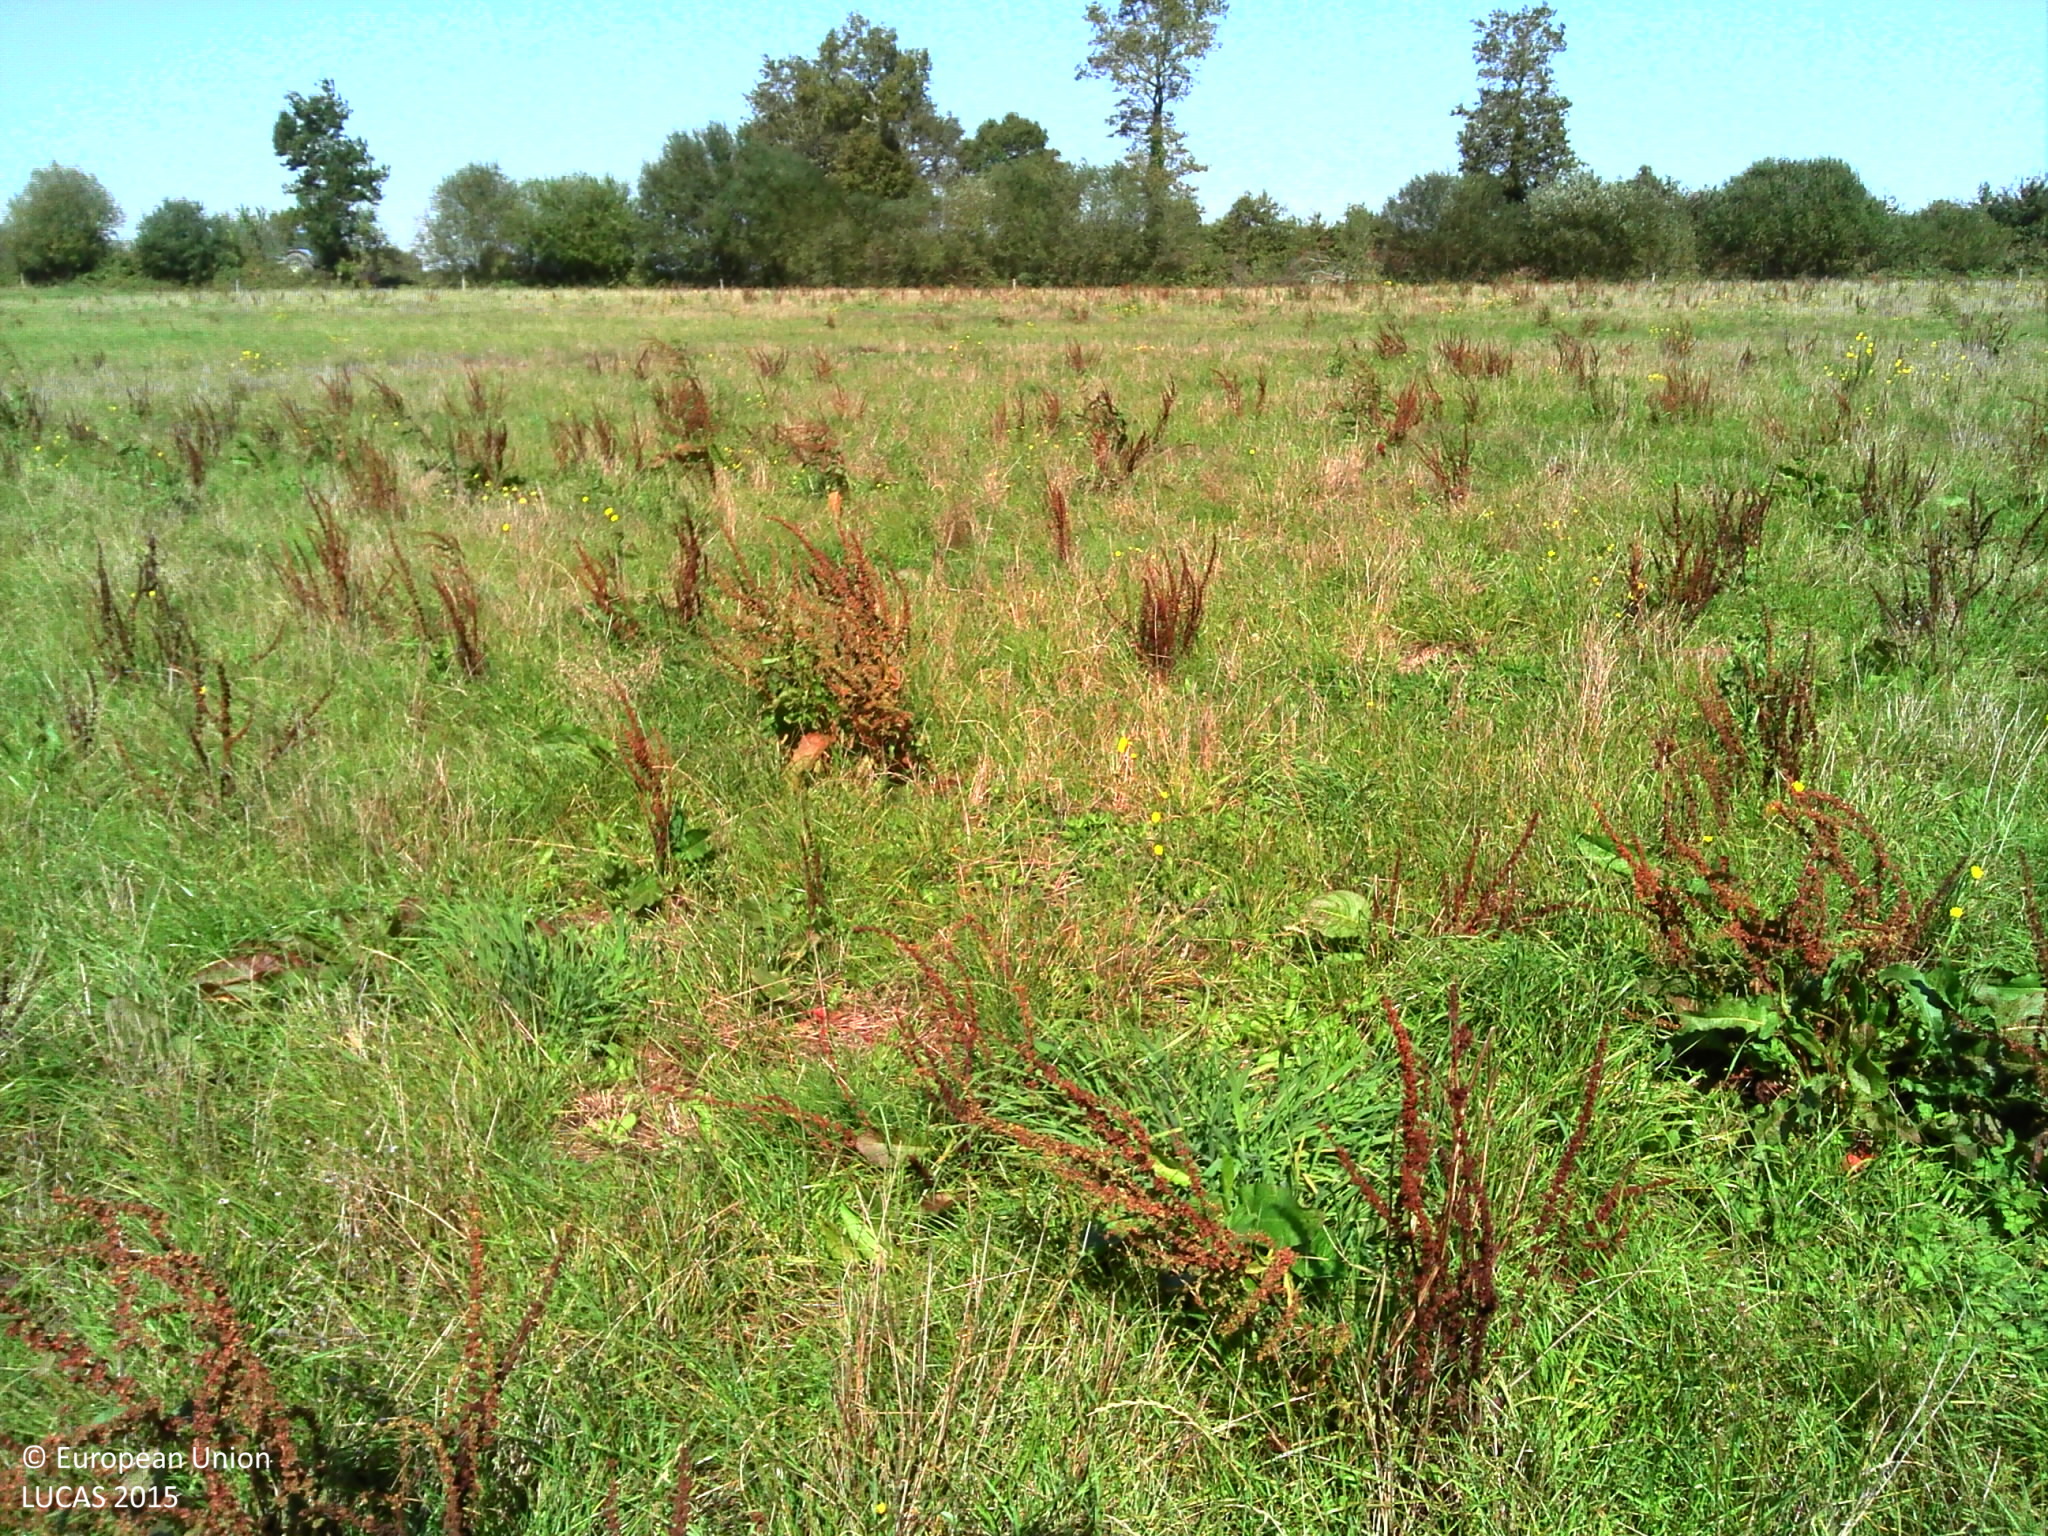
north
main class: Grassland
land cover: Grassland without tree/shrub cover
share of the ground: > 75 %
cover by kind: herbaceous plants 100 %
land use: Agriculture (excluding fallow land and kitchen gardens)
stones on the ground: < 10 %
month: September
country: FR
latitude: 46.6044
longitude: -1.3026
